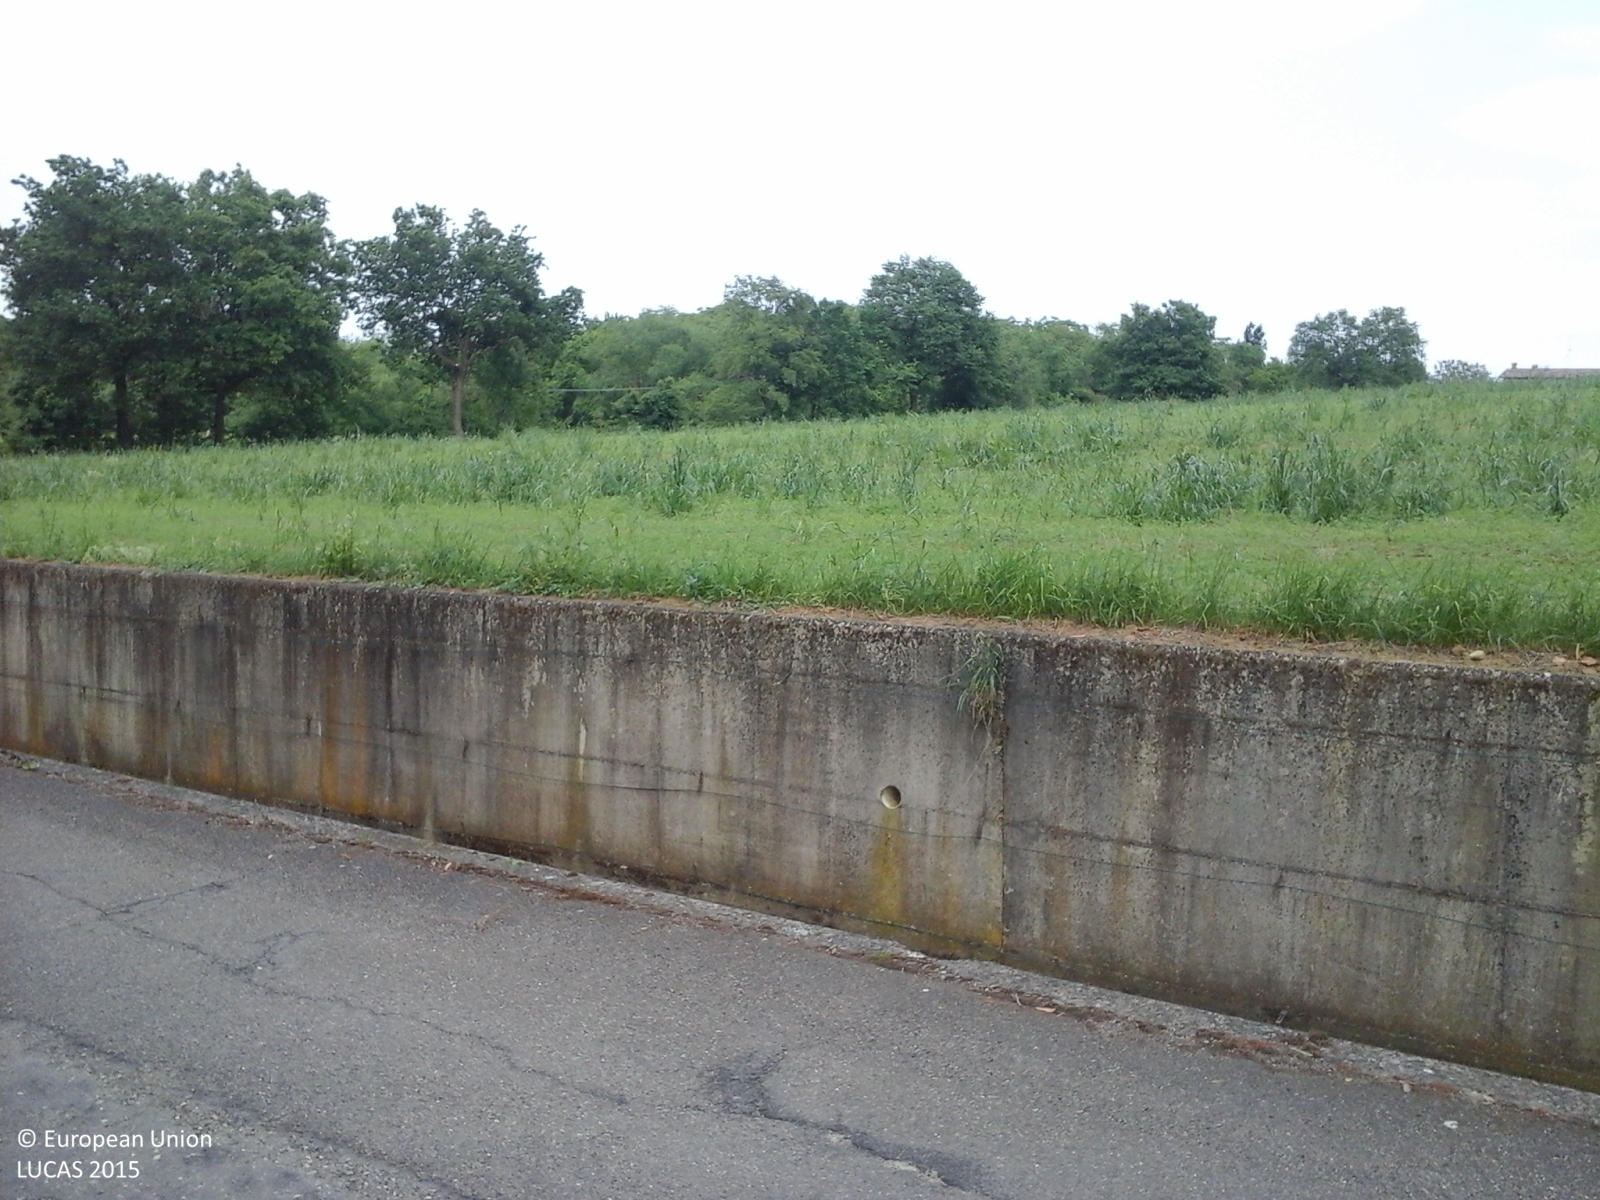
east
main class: Woodland
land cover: Broadleaved woodland
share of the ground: > 75 %
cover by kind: broadleaved forest trees 80 %, herbaceous plants 20 %
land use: Residential
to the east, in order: Broadleaved woodland; Artificial constructions in urban areas; Lines of trees; Fences; Managed hedges; Grass margins; Paved roads, cycling and walking lanes; Artificial constructions; Spontaneously vegetated surfaces; Broadleaved woodland; Electric lines; Paved roads, cycling and walking lanes; Grass margins; Vineyards; Broadleaved woodland
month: May
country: IT
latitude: 44.5825
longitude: 10.7163
